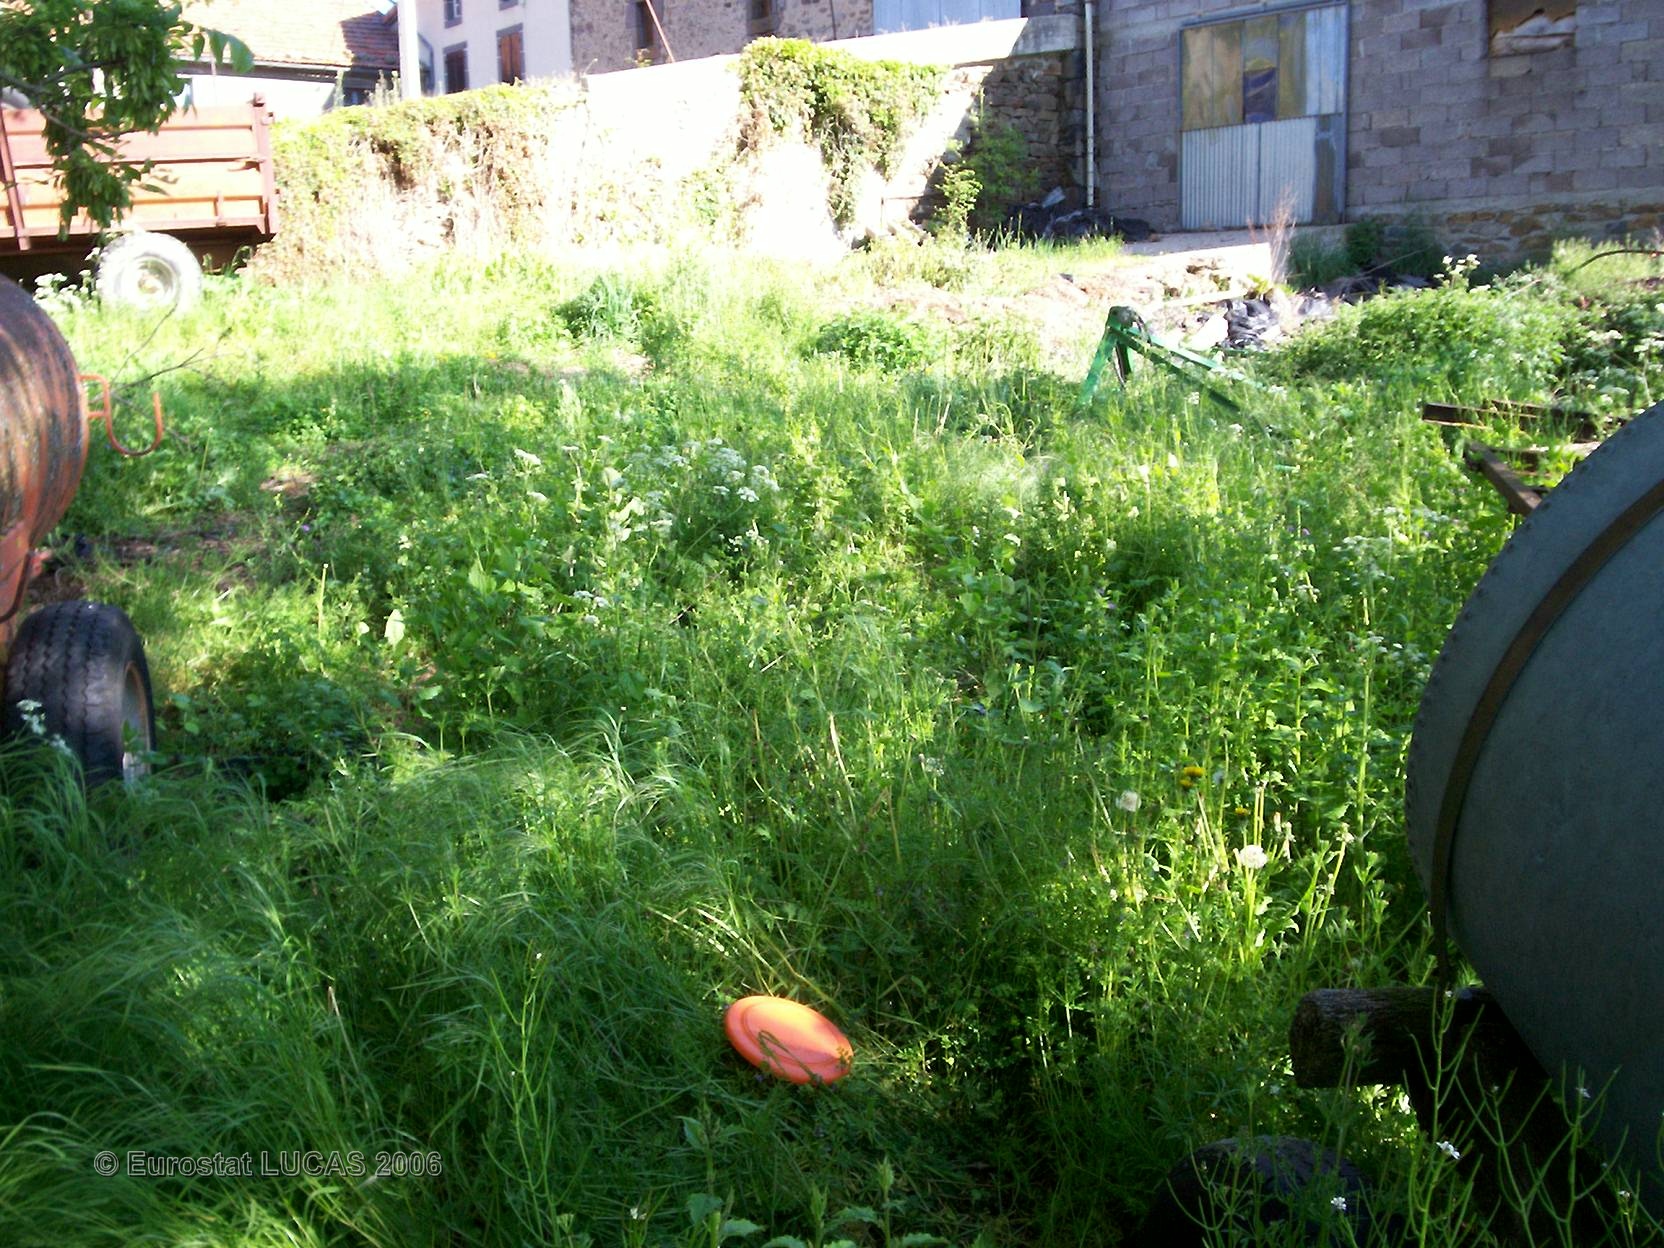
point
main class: Grassland
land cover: Grassland with sparse tree/shrub cover
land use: Agriculture (excluding fallow land and kitchen gardens)
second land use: Residential
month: June
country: FR
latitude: 45.1436
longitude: 3.2493
